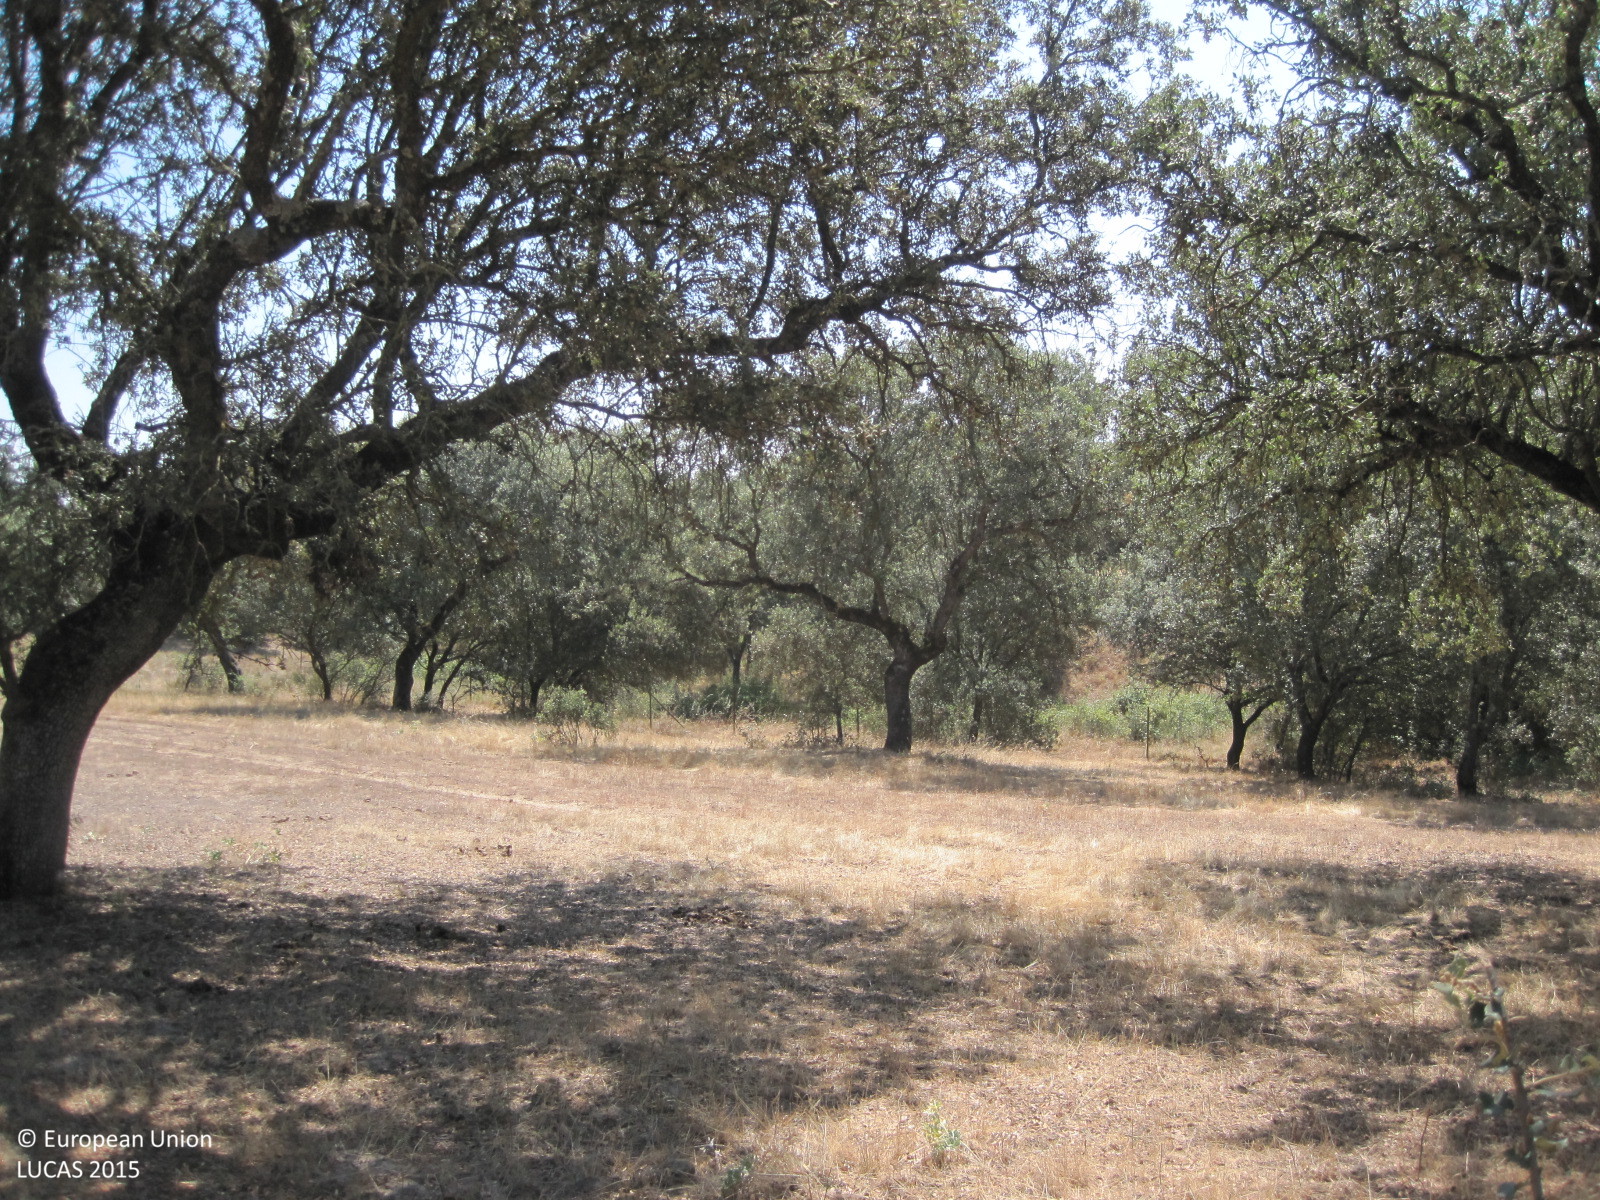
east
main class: Woodland
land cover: Broadleaved woodland
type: broadleaved evergreen forest
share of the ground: 50 - 75 %
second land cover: Shrubland without tree cover
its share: 50 - 75 %
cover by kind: broadleaved forest trees 65 %, shrubs 25 %, herbaceous plants 10 %
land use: Forestry
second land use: Agriculture (excluding fallow land and kitchen gardens)
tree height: > 5 m
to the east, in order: Broadleaved woodland; Shrubland without tree cover; Broadleaved woodland; Tracks; Broadleaved woodland
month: July
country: ES
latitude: 39.9518
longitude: -5.1168
